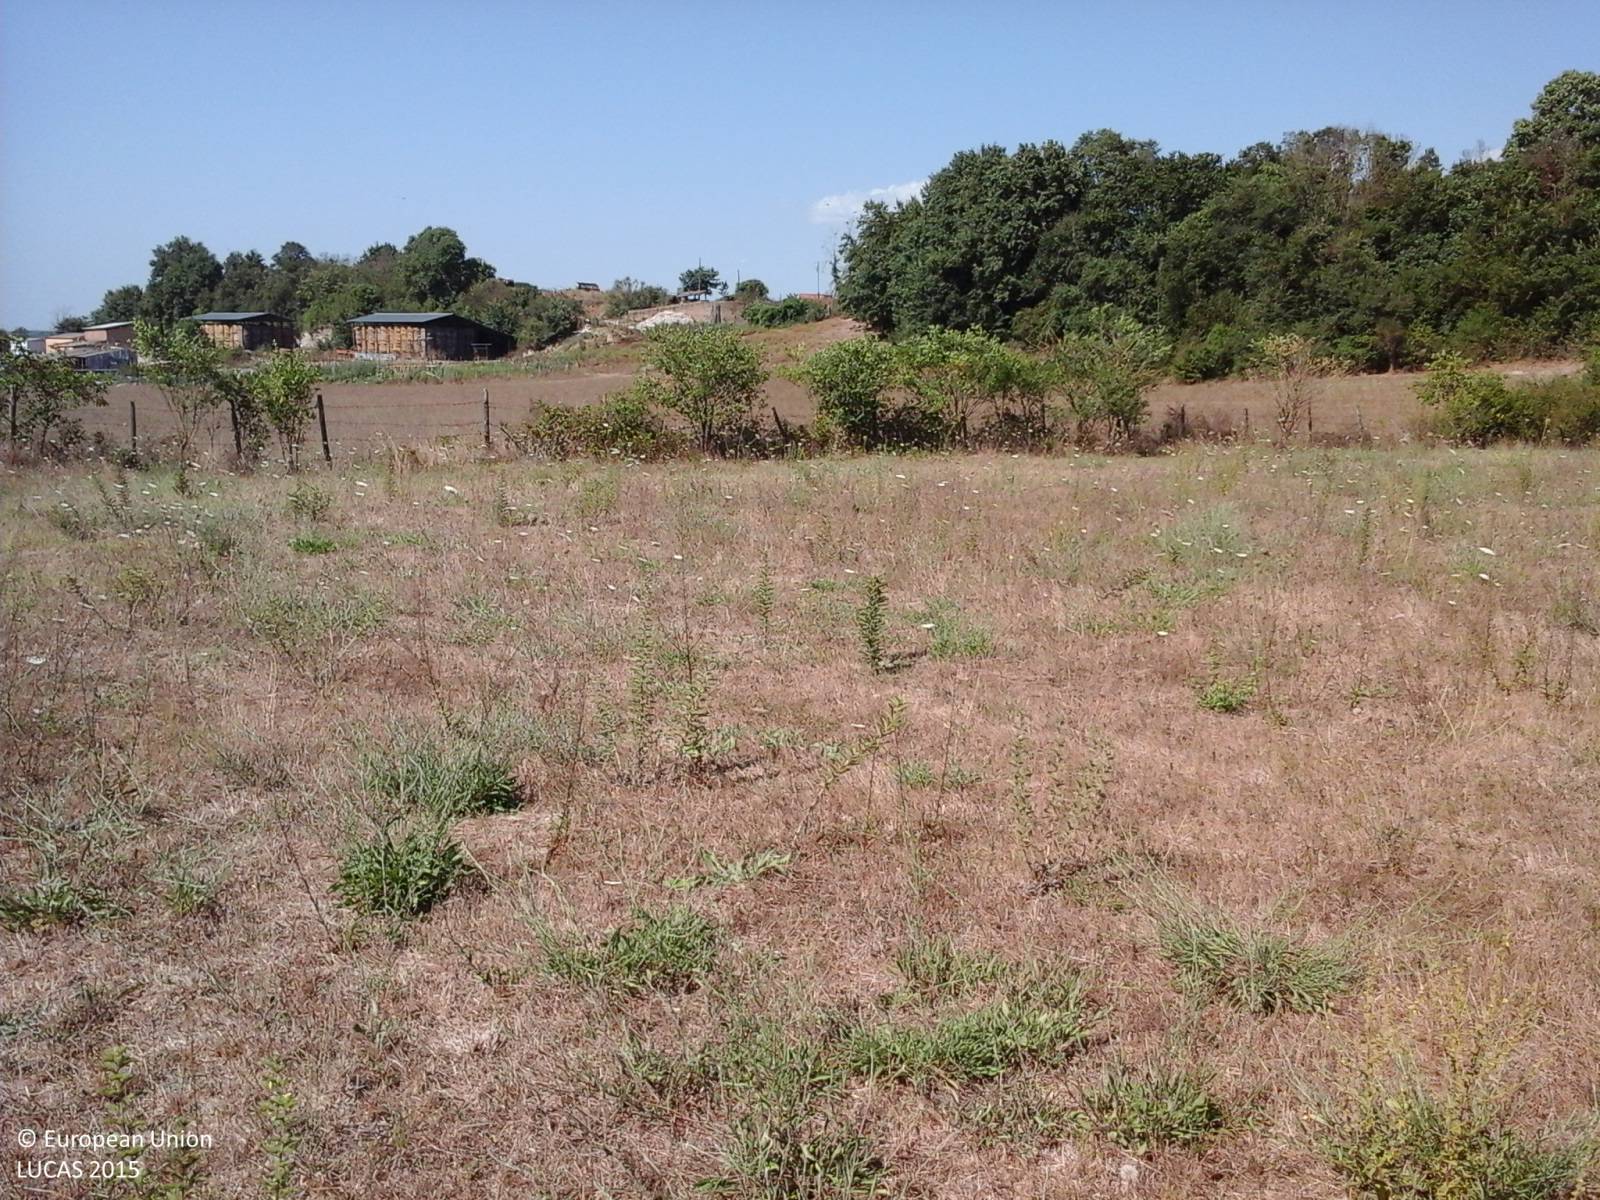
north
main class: Grassland
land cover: Grassland without tree/shrub cover
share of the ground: > 75 %
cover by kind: herbaceous plants 100 %
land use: Agriculture (excluding fallow land and kitchen gardens)
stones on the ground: < 10 %
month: July
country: IT
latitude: 42.1563
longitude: 12.3757
